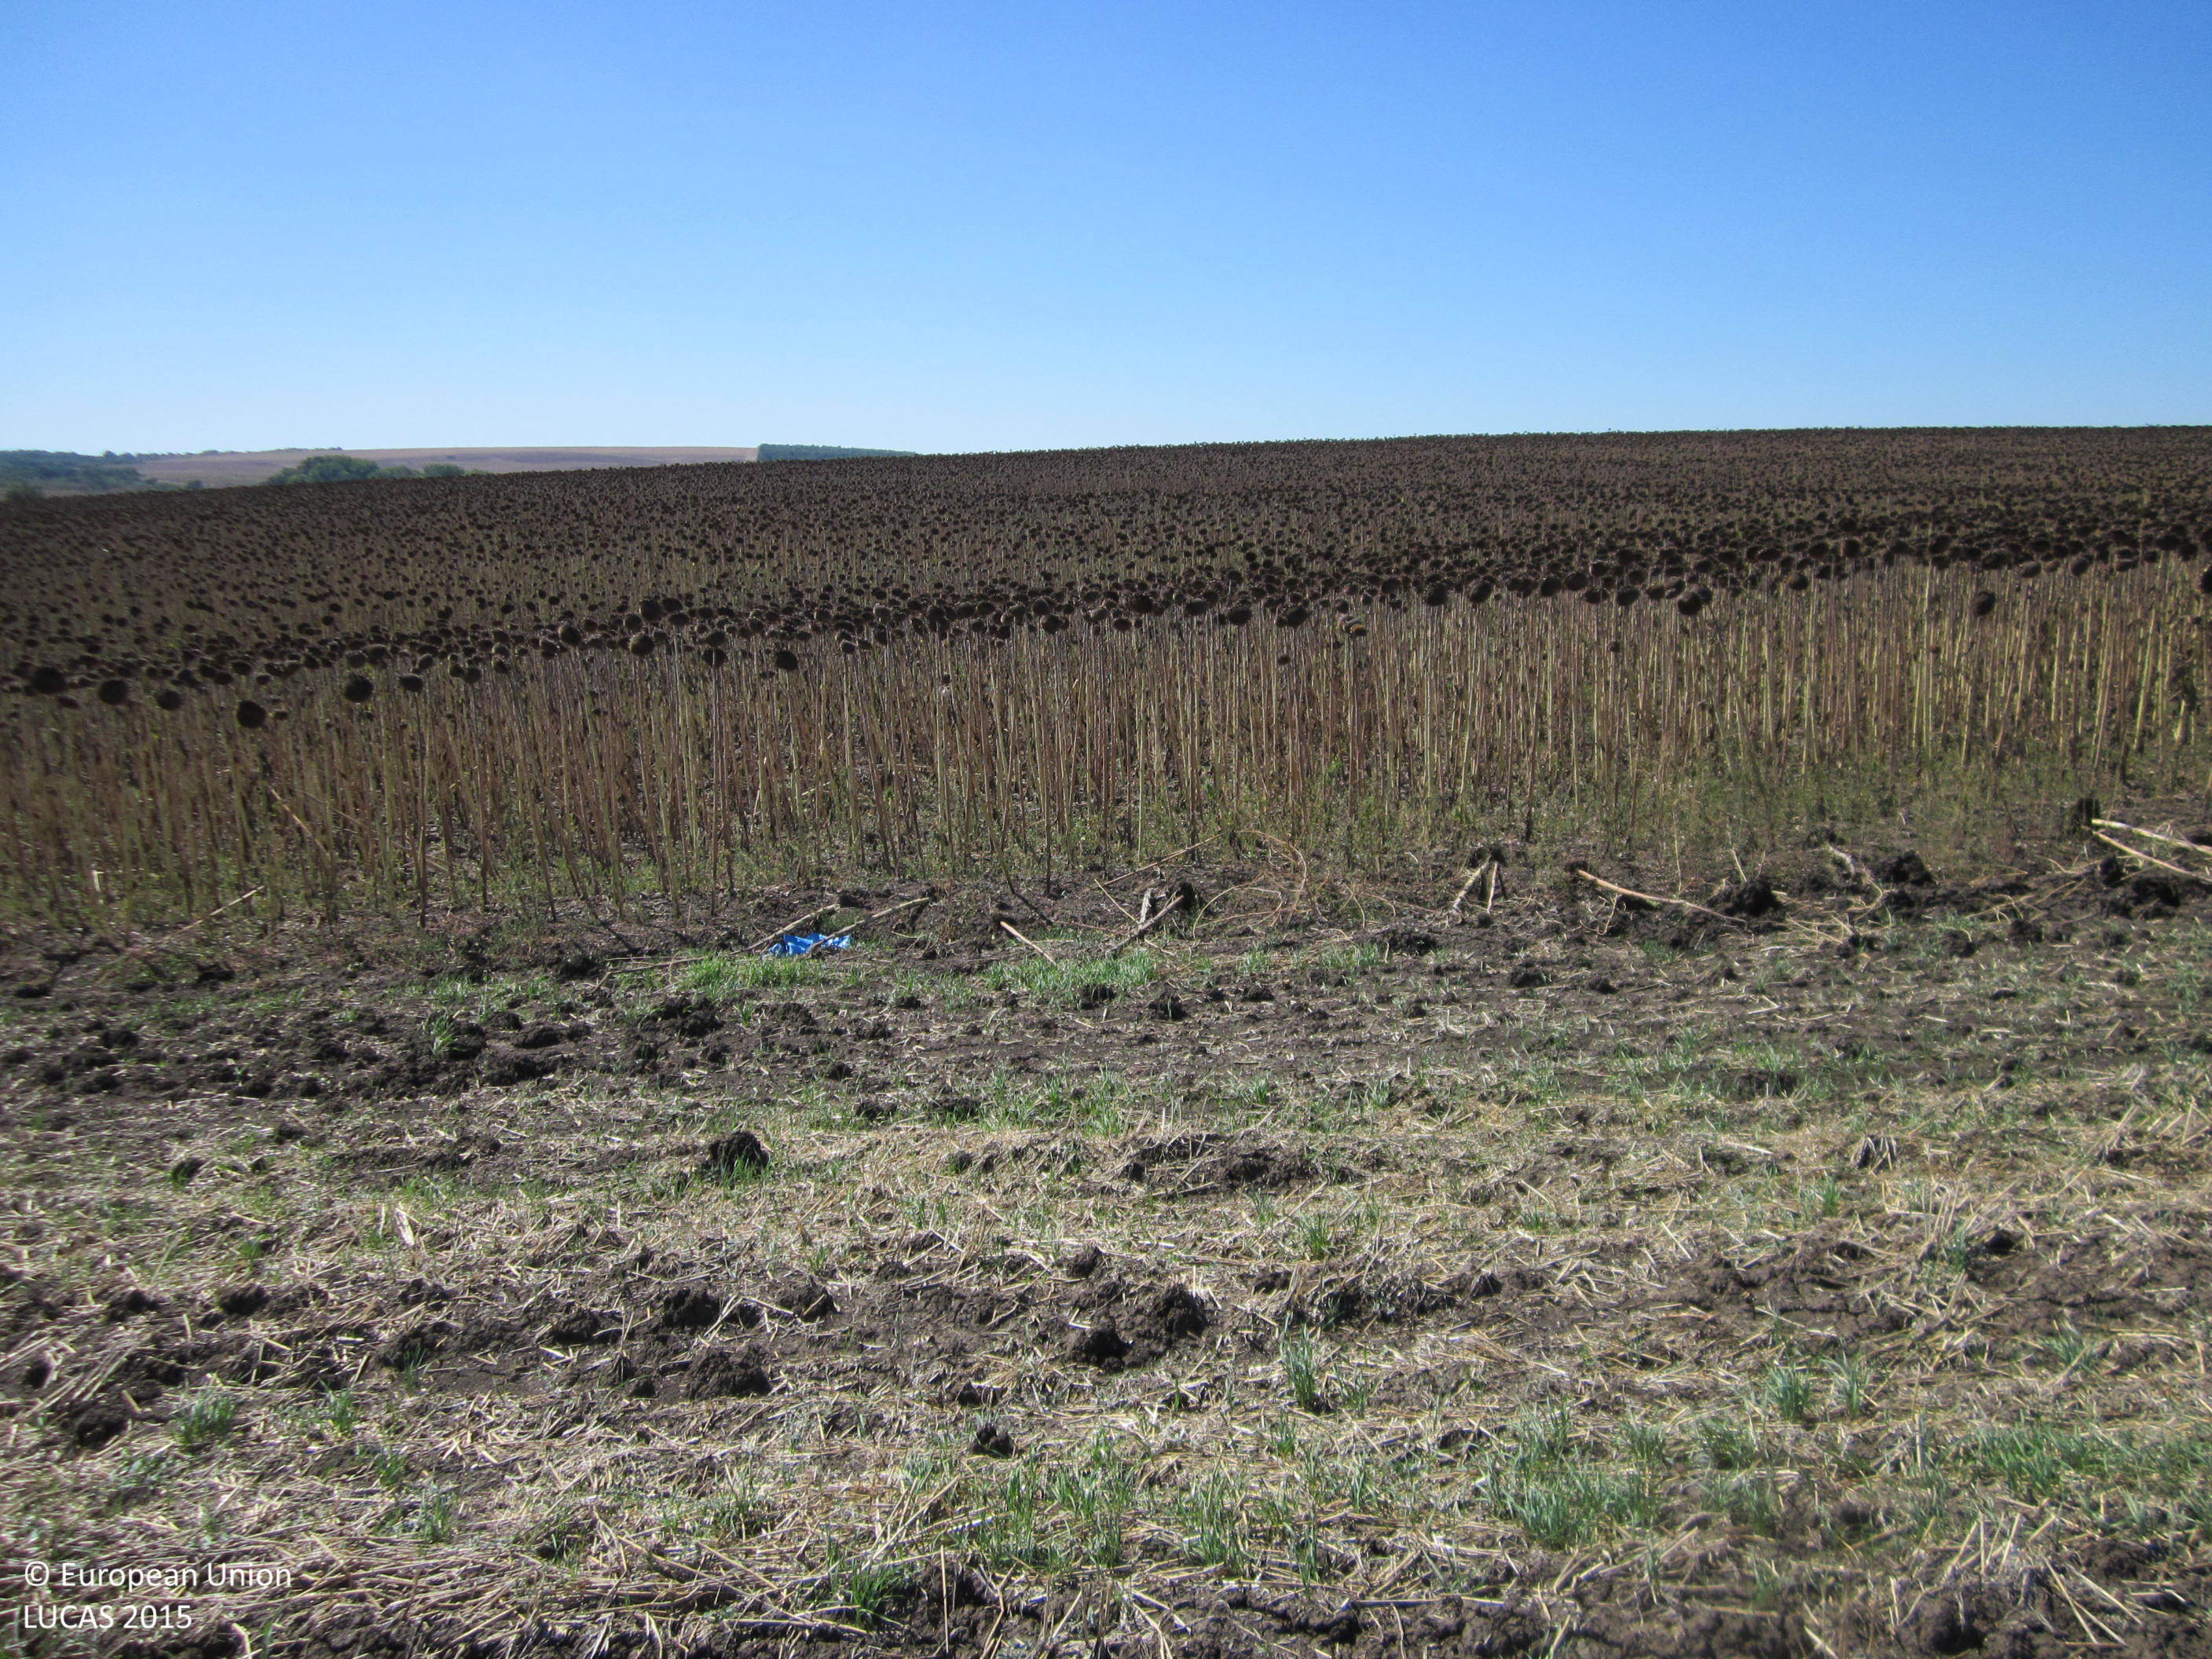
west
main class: Cropland
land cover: Common wheat
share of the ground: 25 - 50 %
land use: Agriculture (excluding fallow land and kitchen gardens)
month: September
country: BG
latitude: 42.4886
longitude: 27.0285
